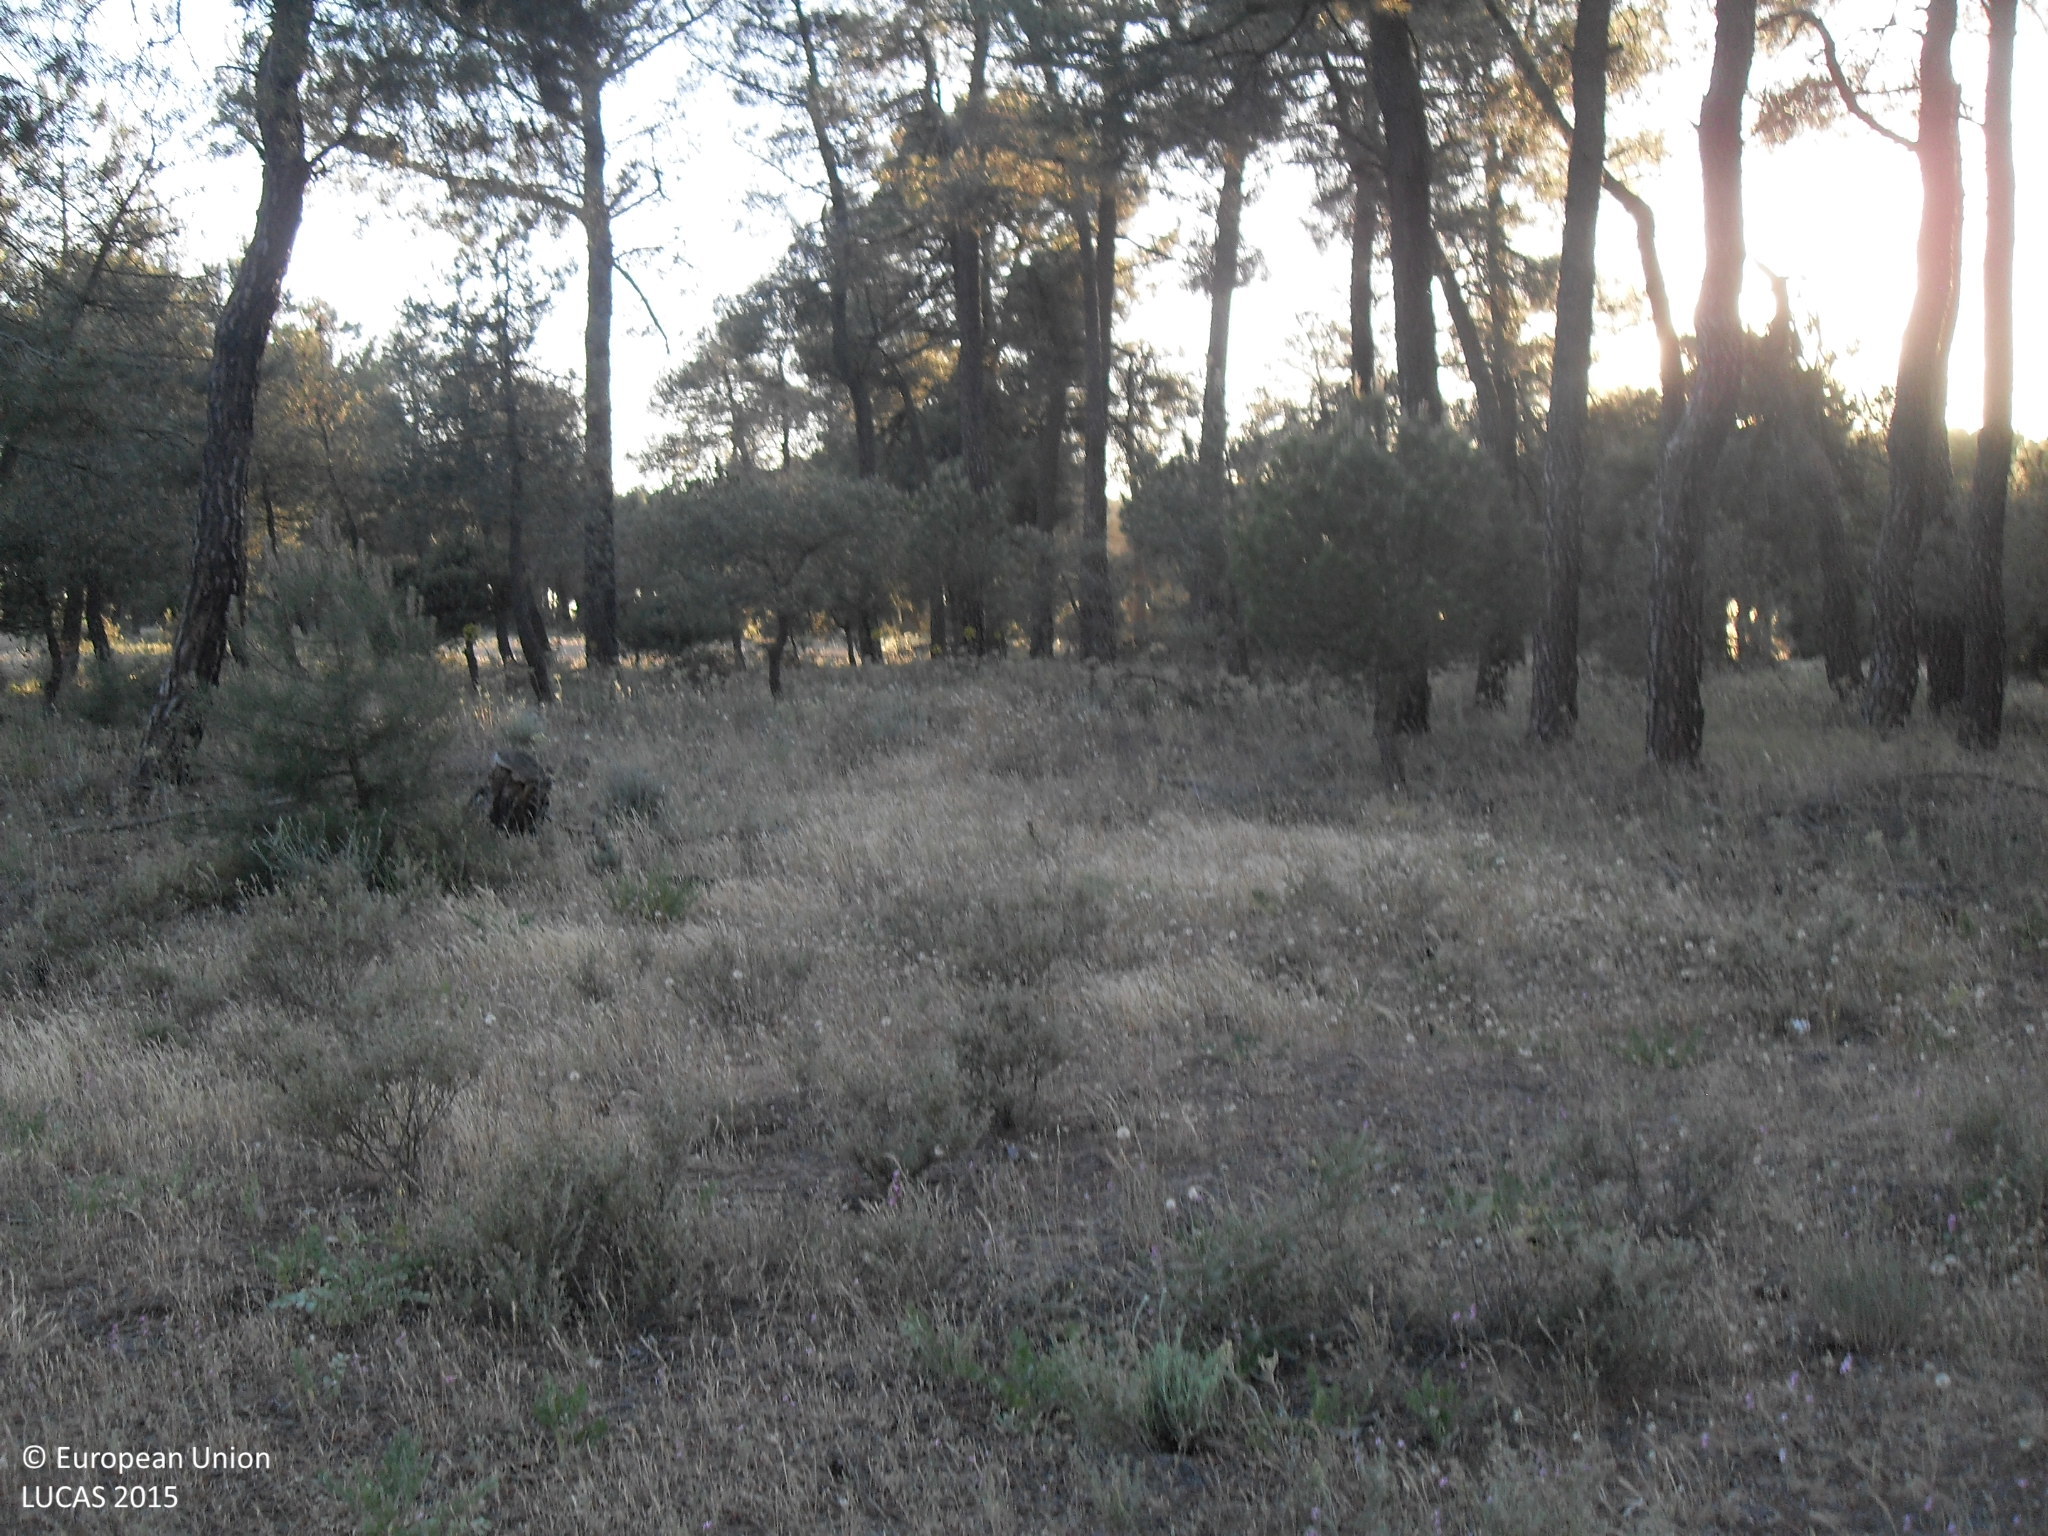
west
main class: Woodland
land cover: Pine dominated coniferous woodland
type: coniferous forest of the mediterranean region
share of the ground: 25 - 50 %
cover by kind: consolidated bare surface 60 %, coniferous forest trees 40 %
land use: Forestry
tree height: > 5 m
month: May
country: ES
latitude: 41.0306
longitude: -5.3803
